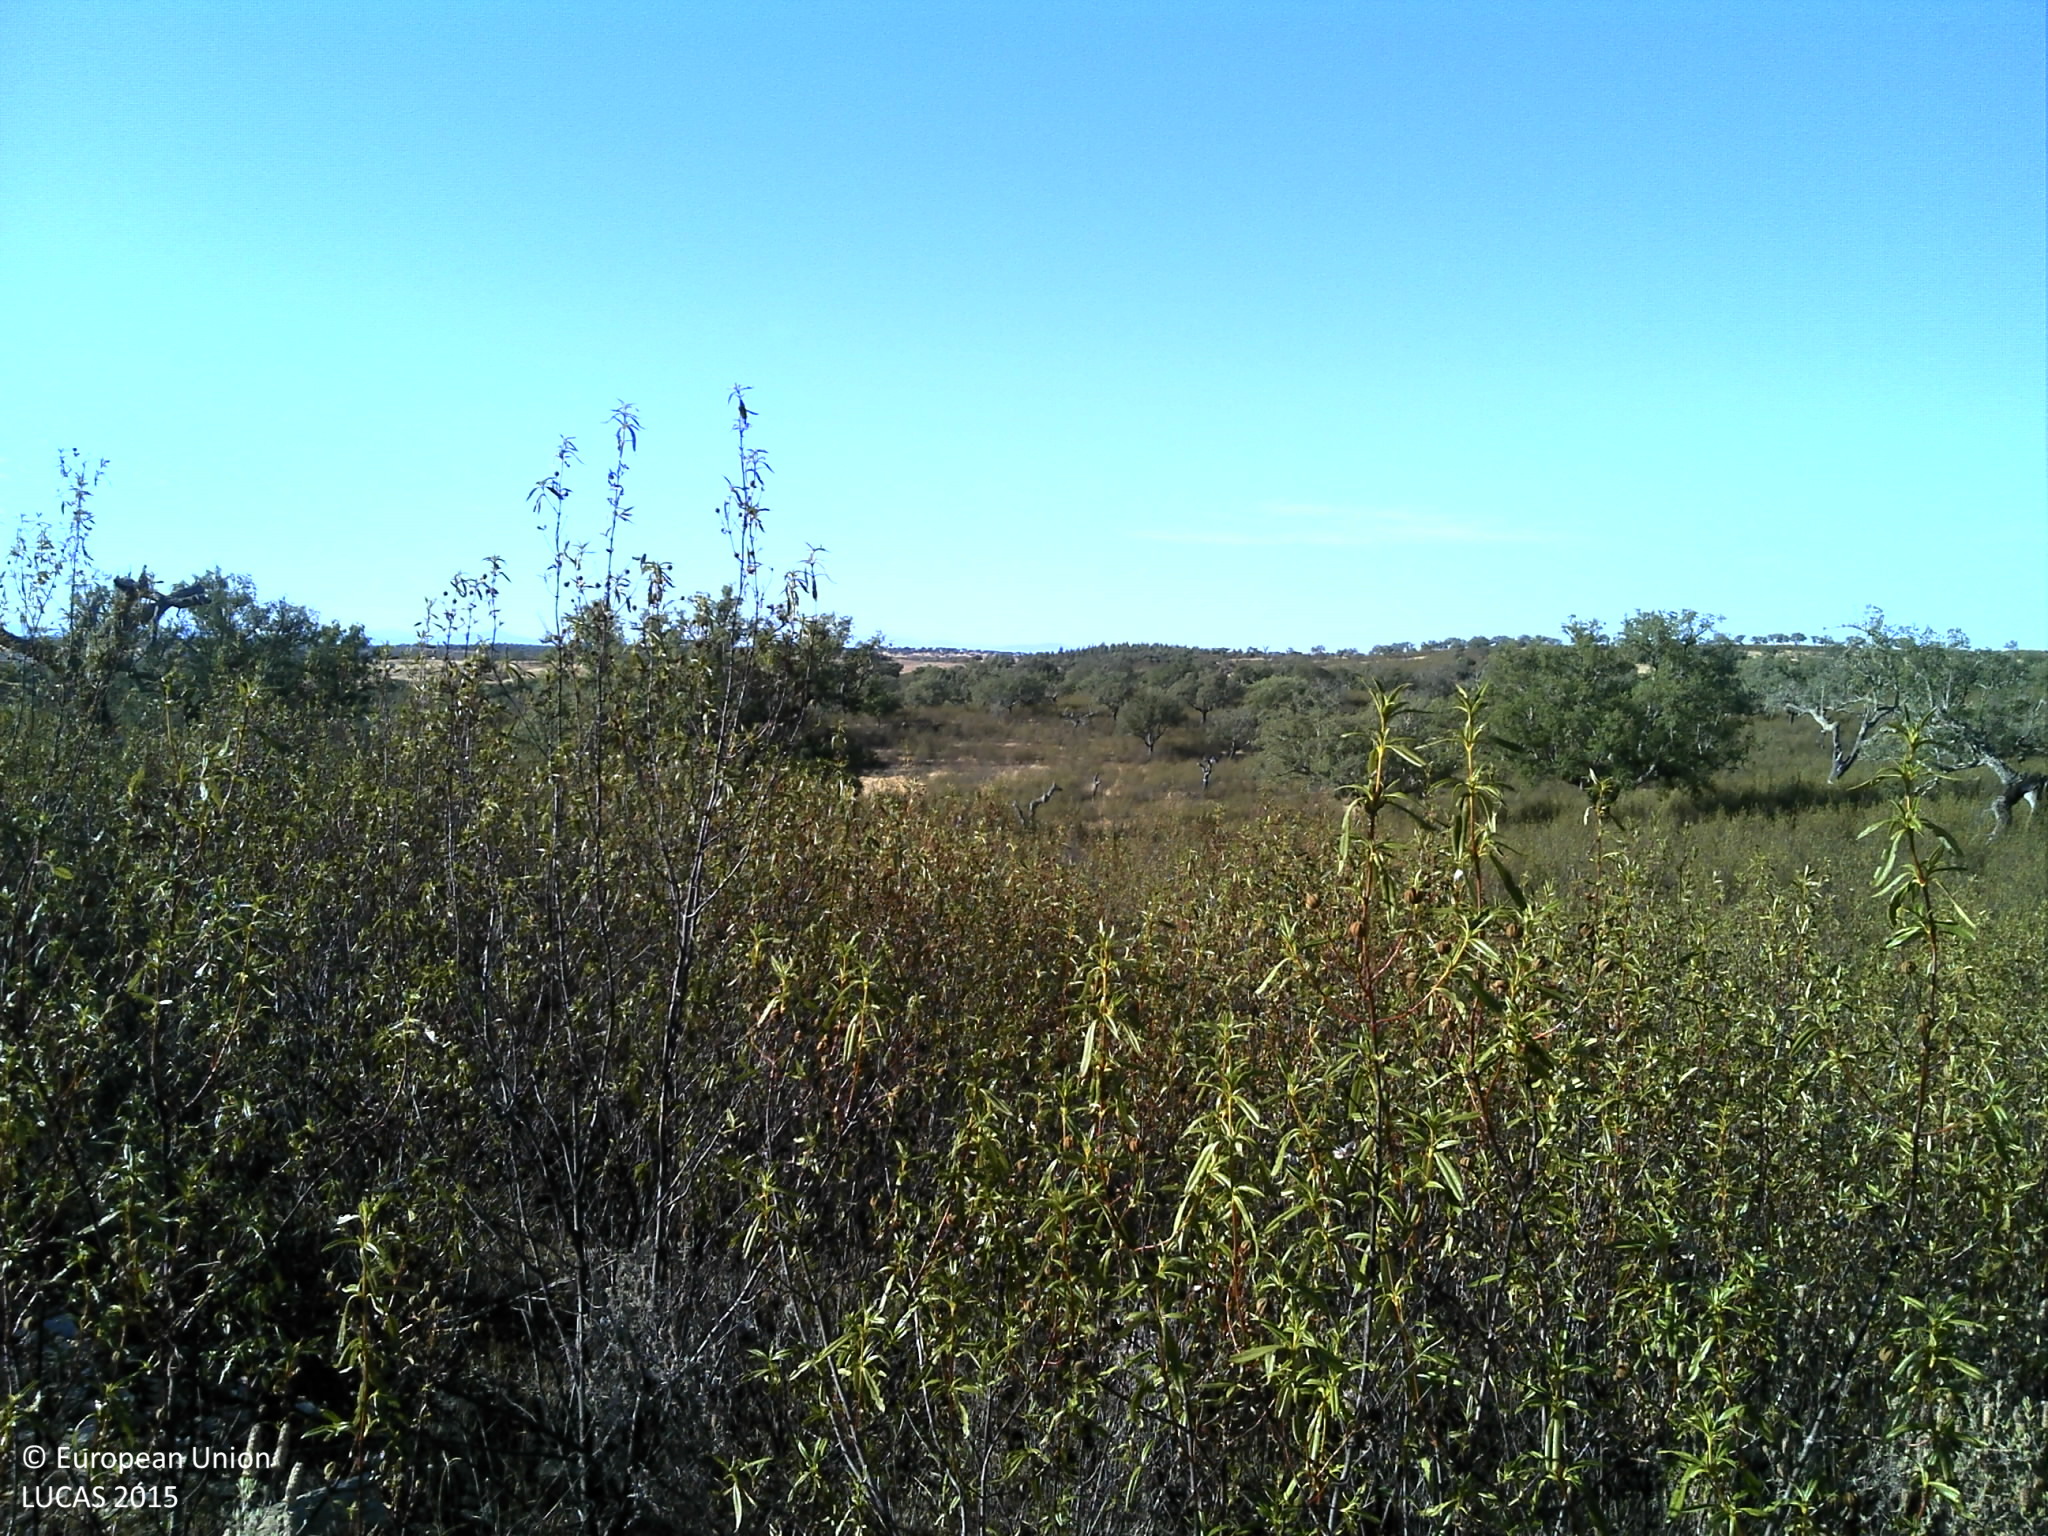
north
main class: Woodland
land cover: Broadleaved woodland
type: broadleaved evergreen forest
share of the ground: 10 - 25 %
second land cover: Shrubland without tree cover
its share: > 75 %
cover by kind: shrubs 85 %, broadleaved forest trees 15 %
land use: Forestry
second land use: Agriculture (excluding fallow land and kitchen gardens)
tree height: > 5 m
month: August
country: PT
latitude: 39.5415
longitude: -7.5371
